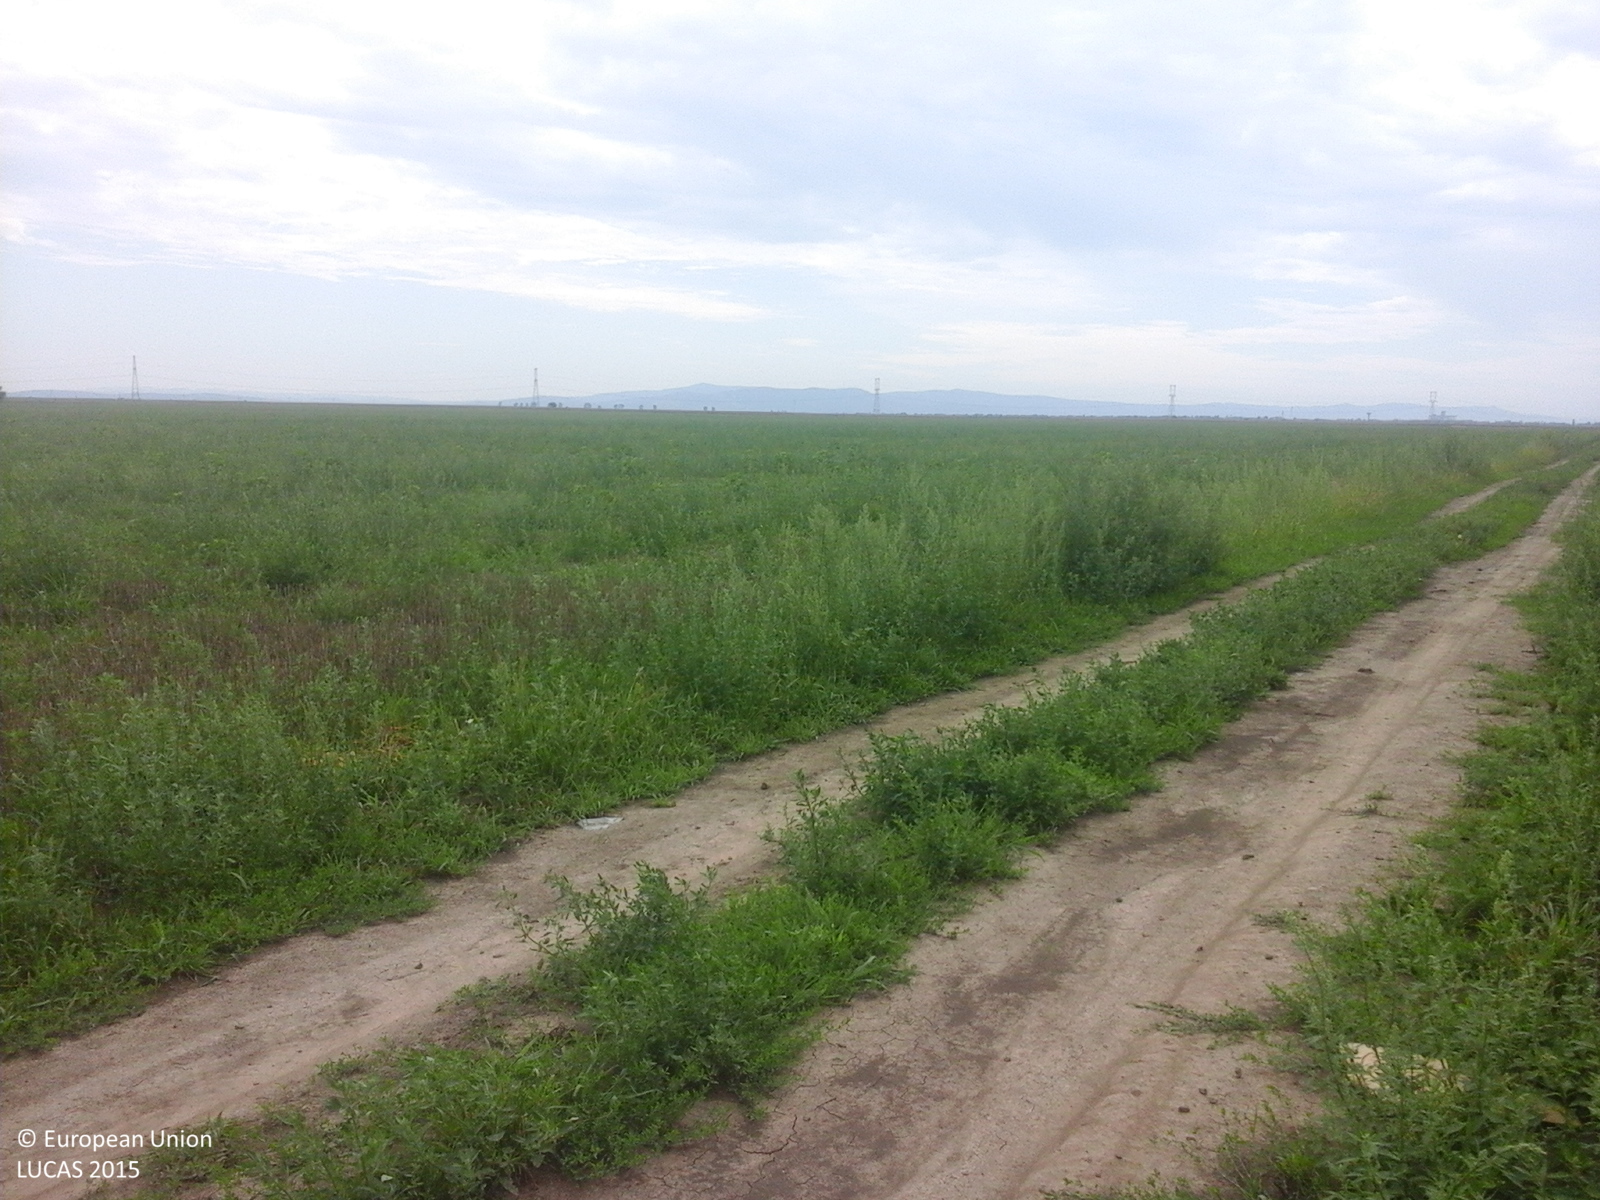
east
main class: Cropland
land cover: Sunflower
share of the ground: > 75 %
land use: Agriculture (excluding fallow land and kitchen gardens)
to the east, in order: Sunflower
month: August
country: RO
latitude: 46.3869
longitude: 21.4667
